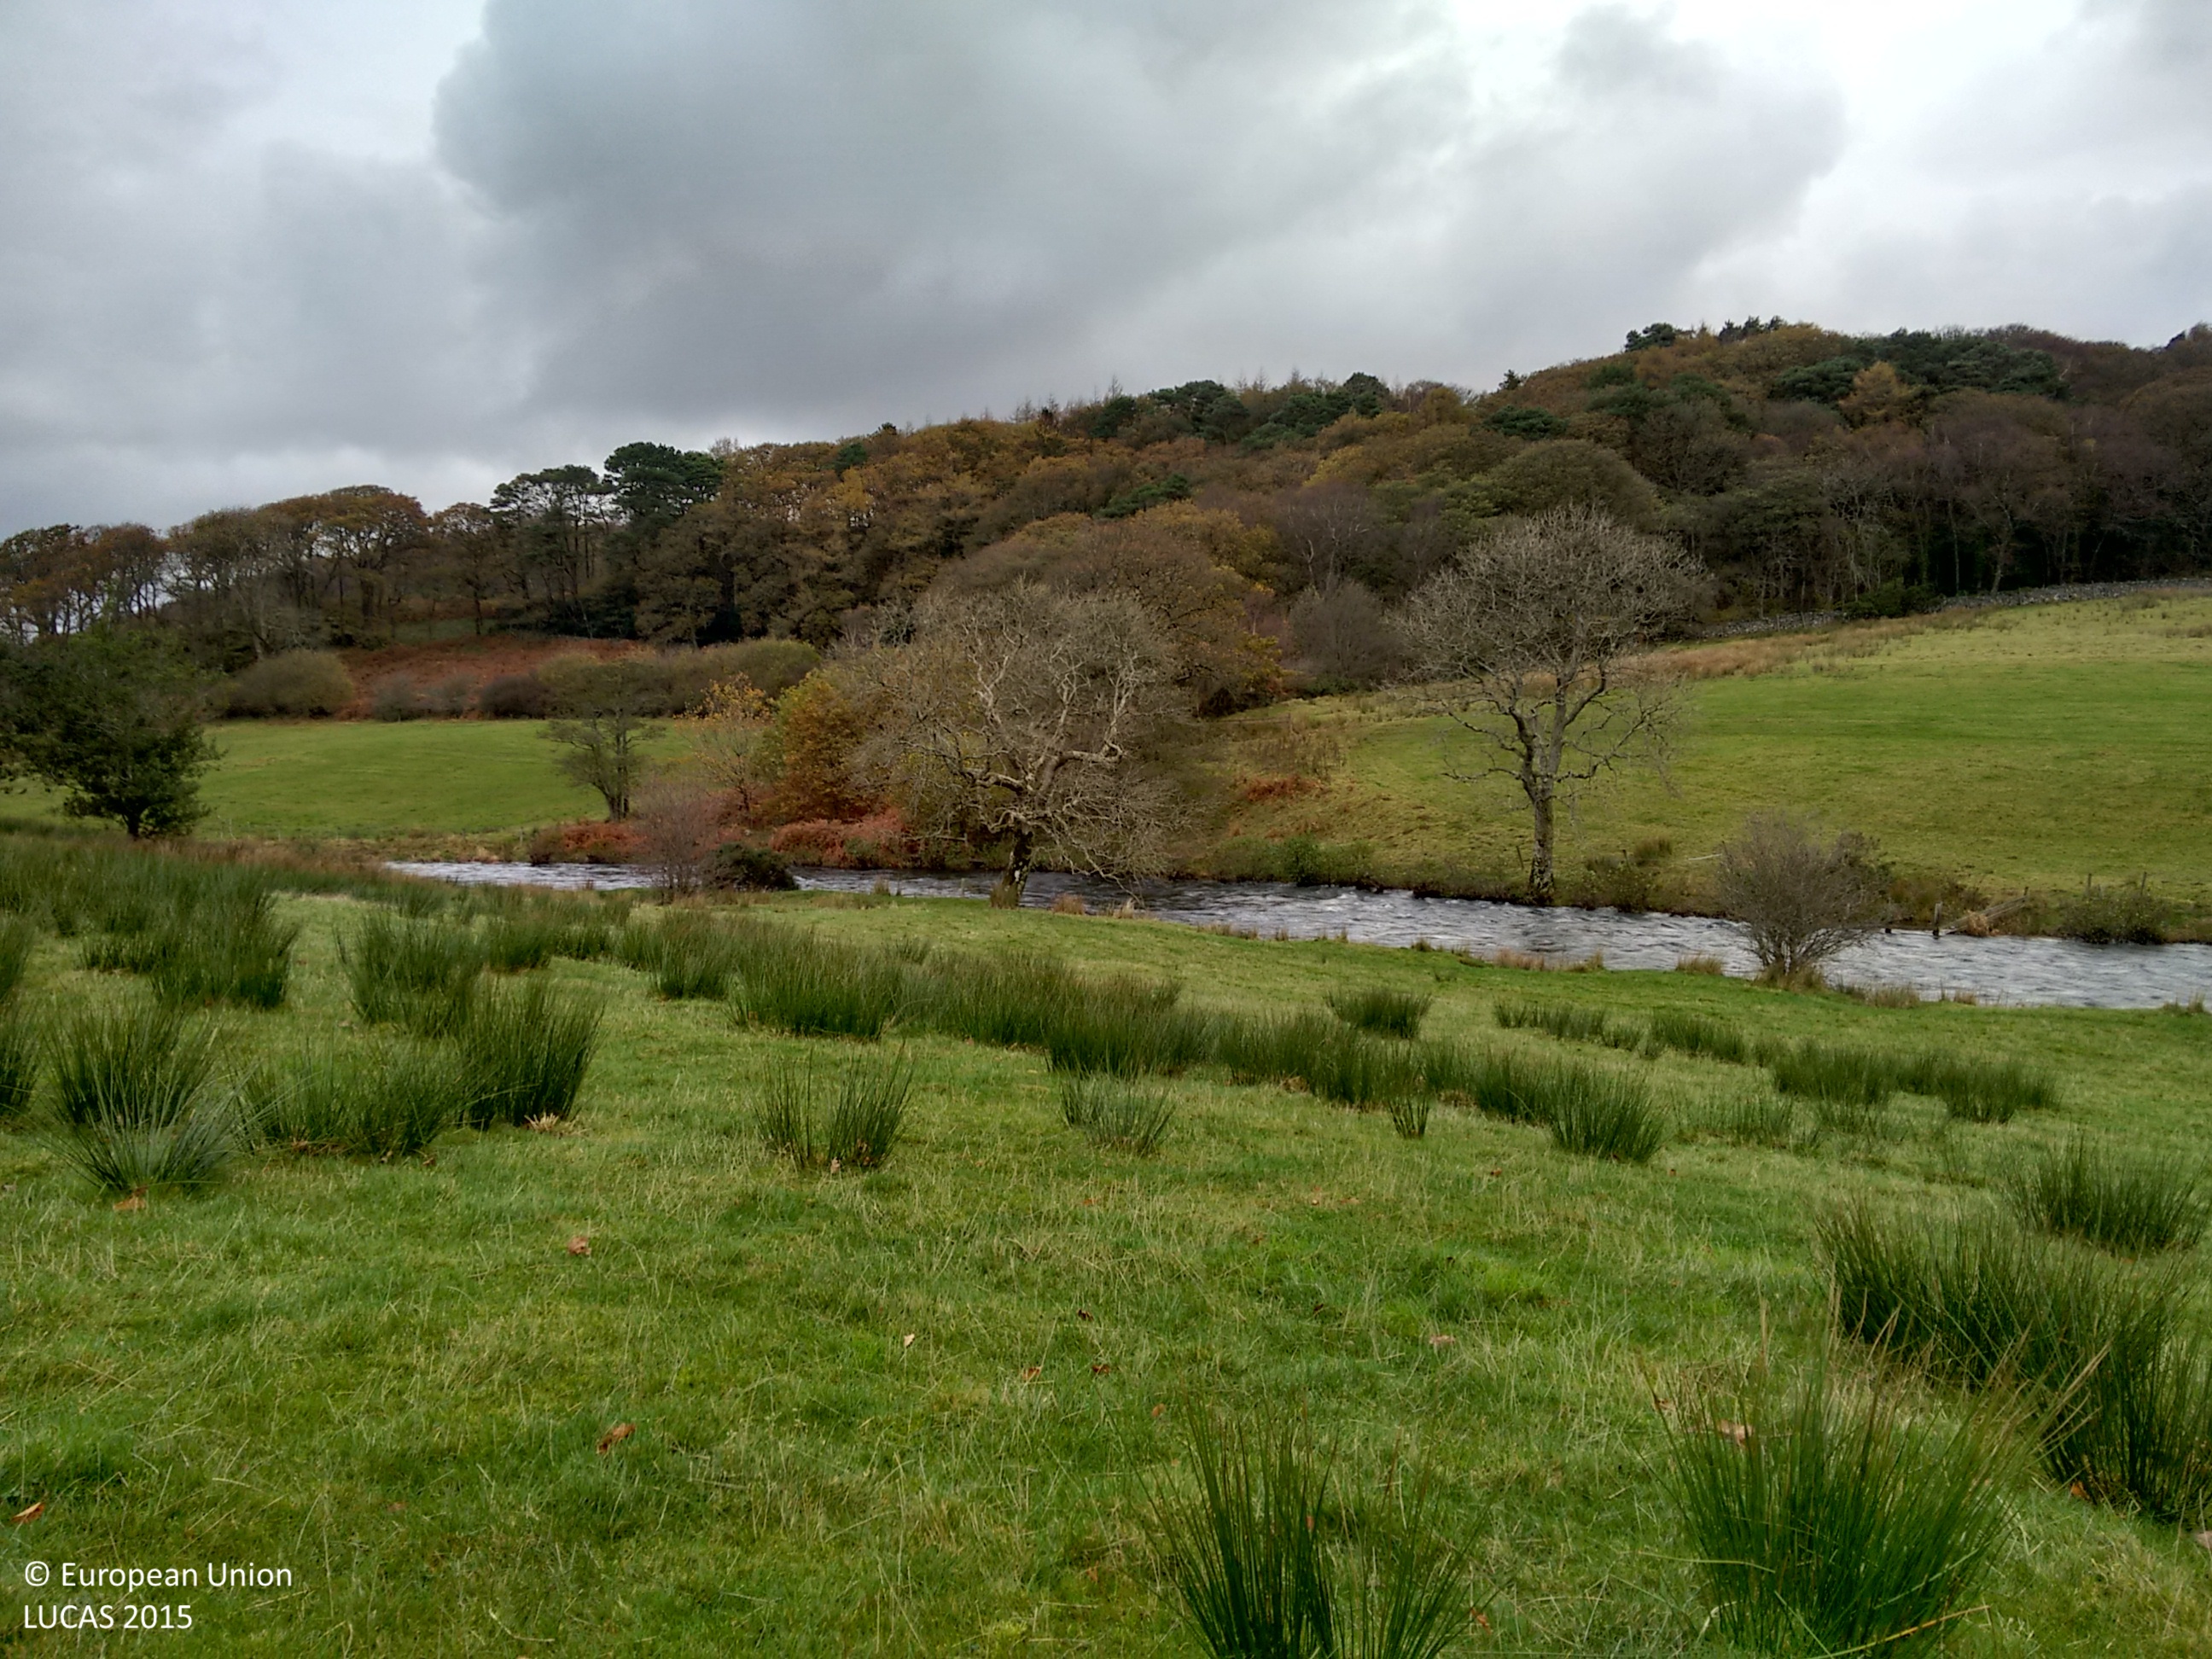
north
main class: Grassland
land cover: Grassland without tree/shrub cover
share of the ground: > 75 %
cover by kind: herbaceous plants 100 %
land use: Agriculture (excluding fallow land and kitchen gardens)
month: November
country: GB
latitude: 54.4066
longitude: -3.3753
